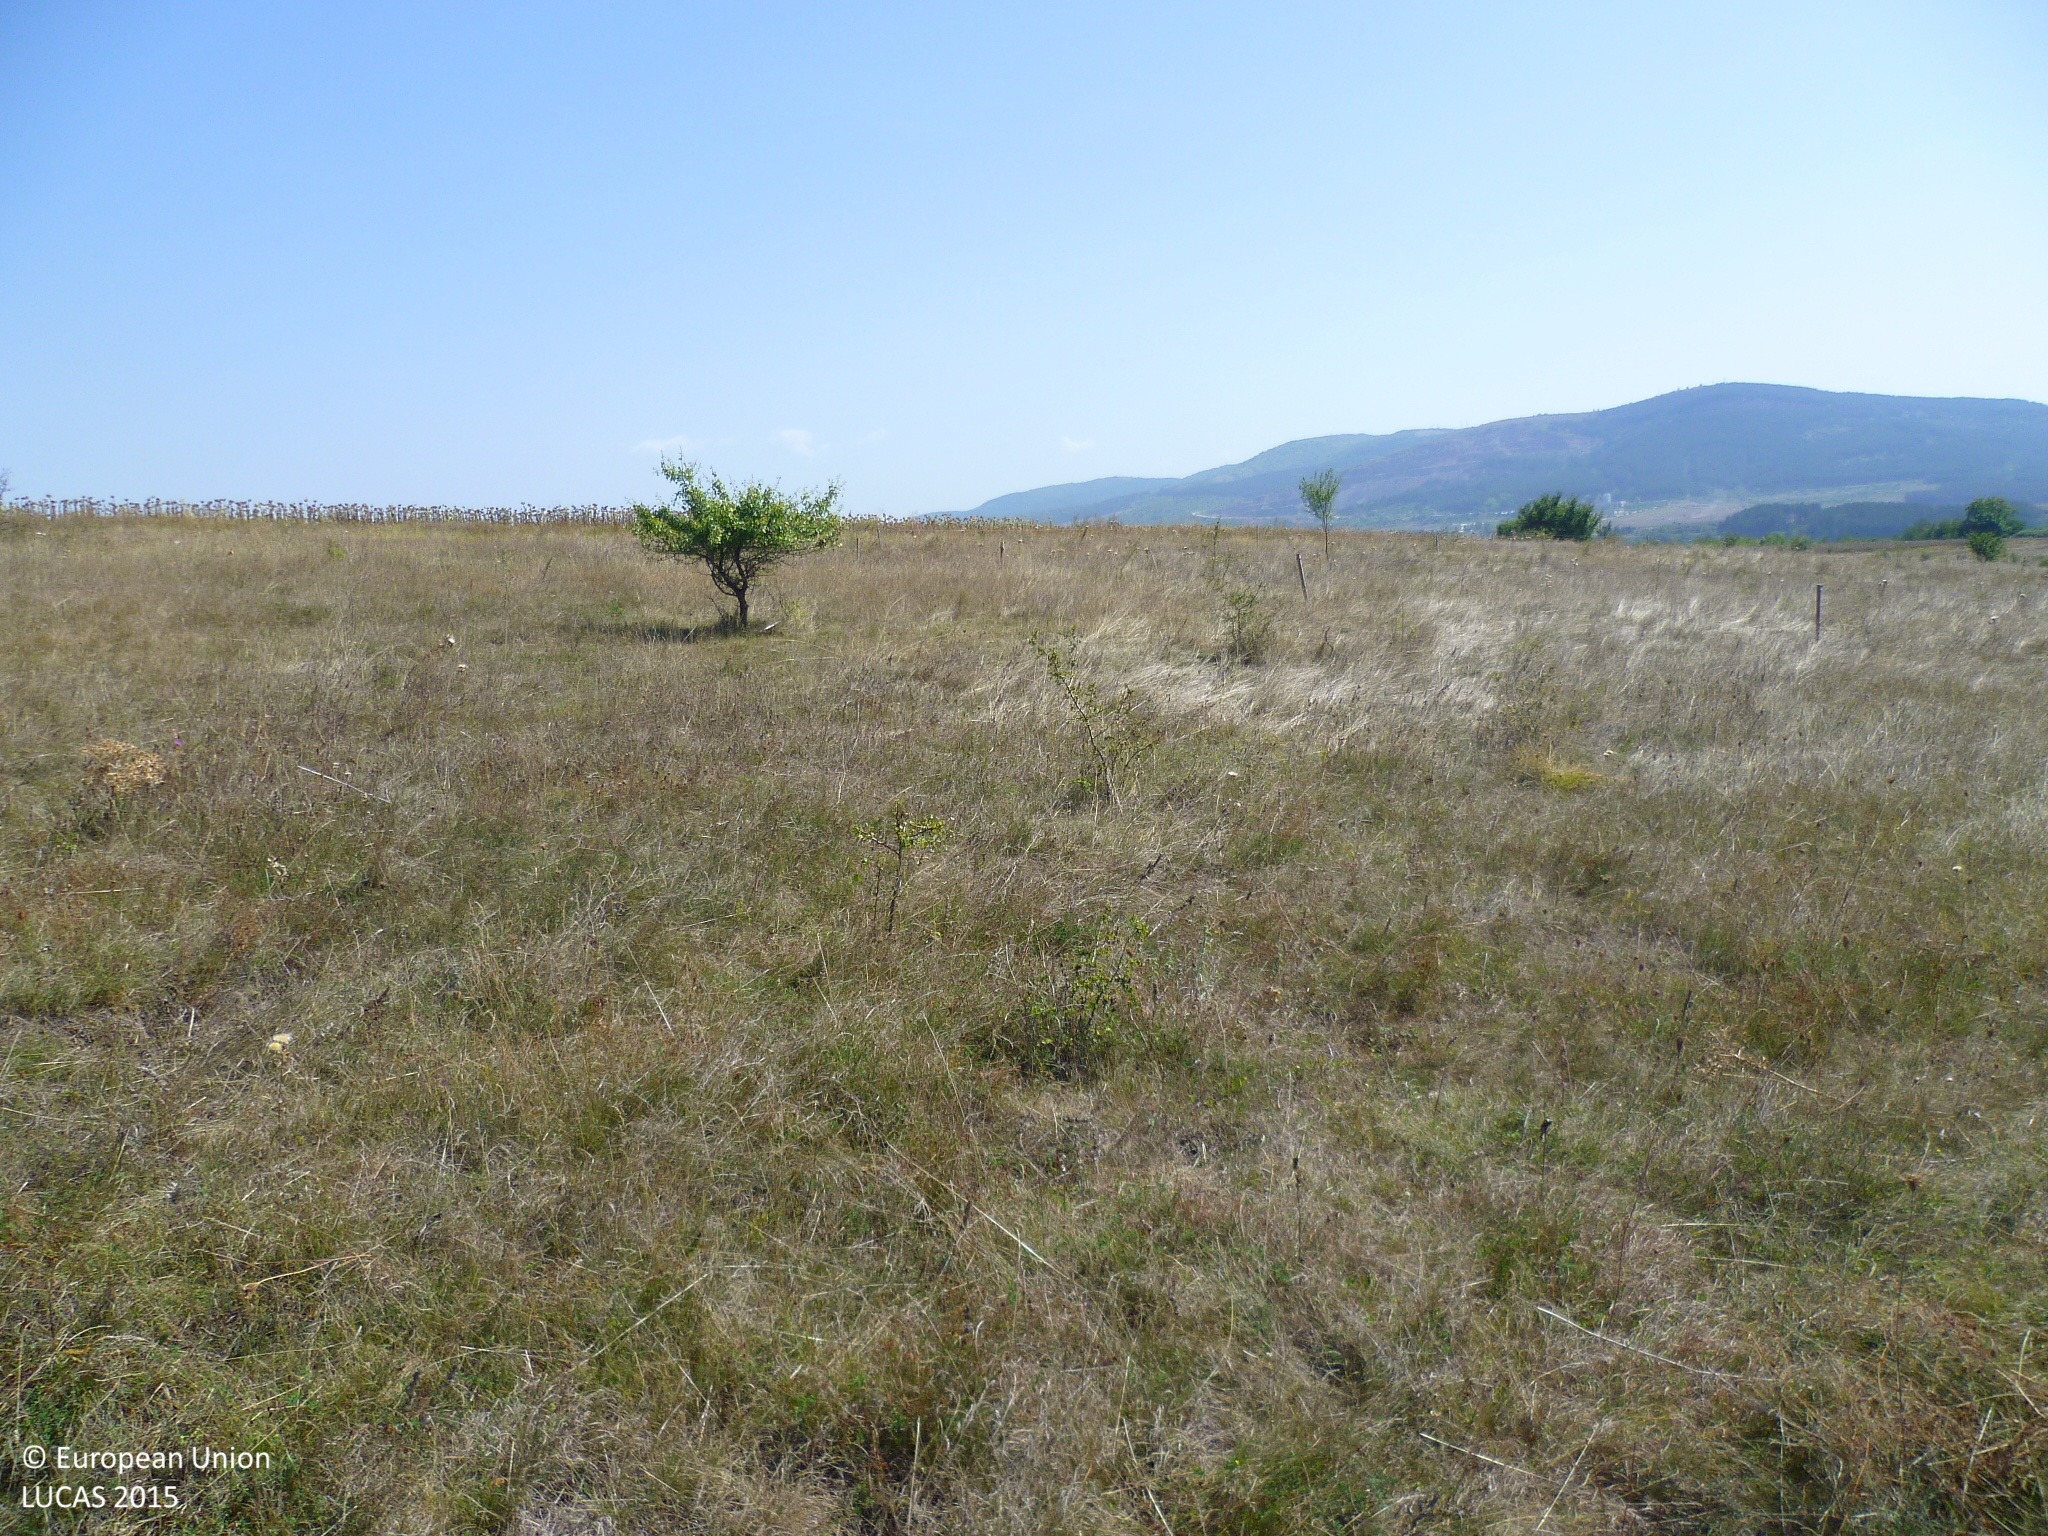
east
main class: Grassland
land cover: Grassland with sparse tree/shrub cover
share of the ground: > 75 %
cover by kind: herbaceous plants 90 %, broadleaved forest trees 5 %, shrubs 5 %
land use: Agriculture (excluding fallow land and kitchen gardens)
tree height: < 5 m
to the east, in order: Grassland with sparse tree/shrub cover; Tracks; Grass margins; Sunflower
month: September
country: BG
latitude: 42.6060
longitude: 22.9363
